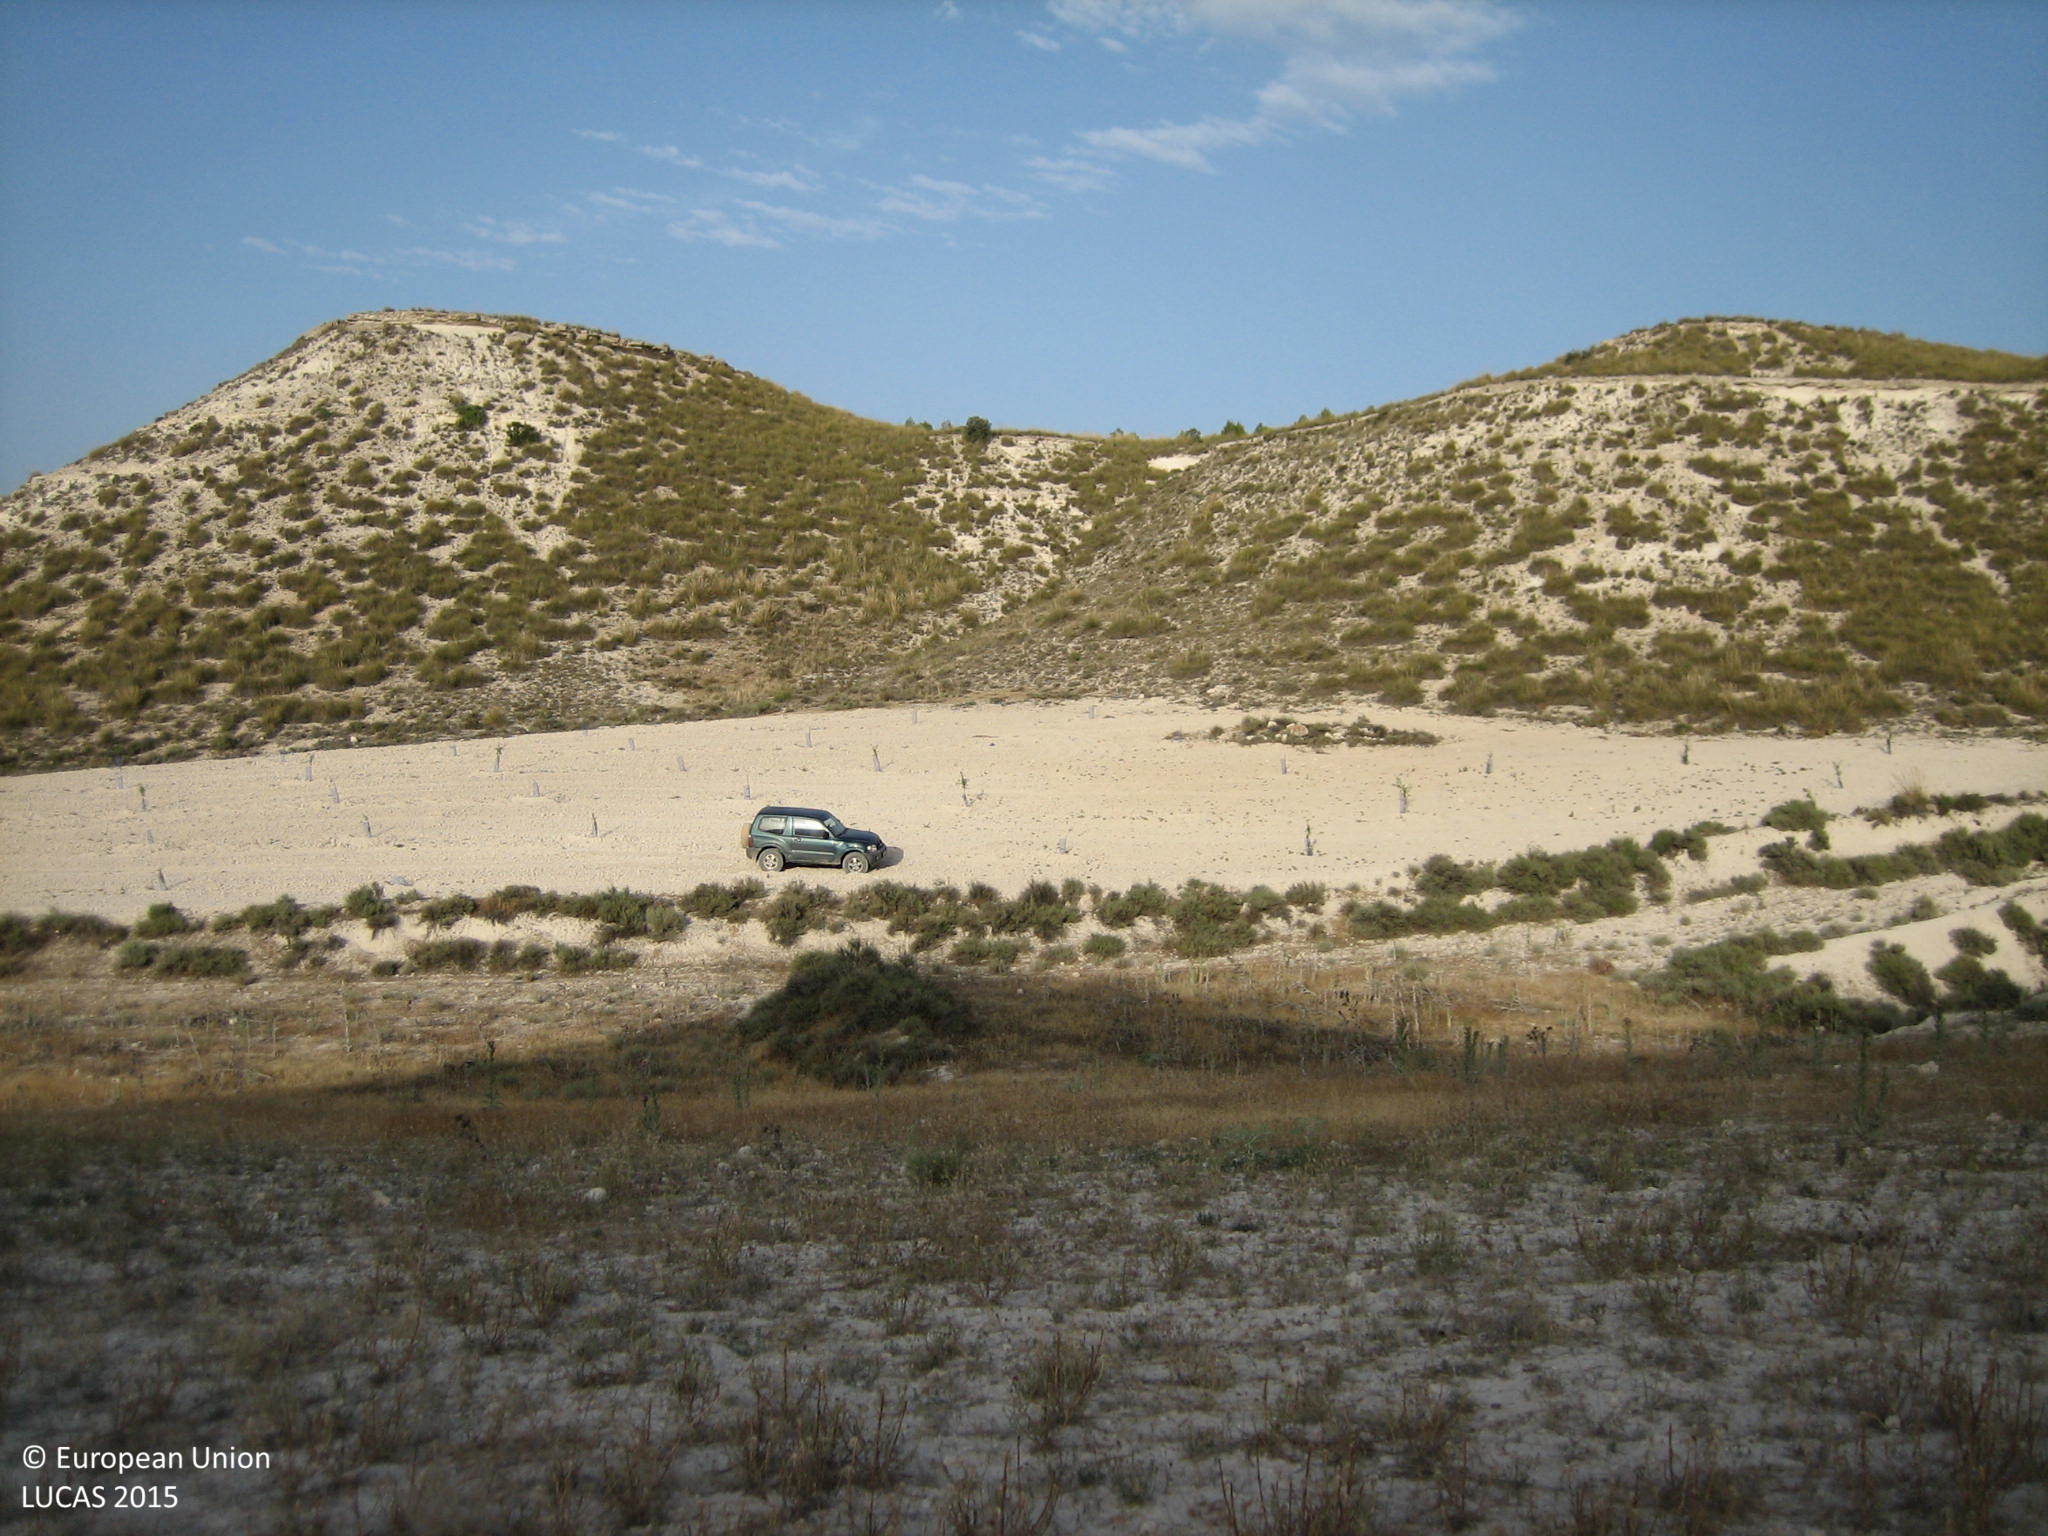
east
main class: Grassland
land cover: Spontaneously vegetated surfaces
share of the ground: 25 - 50 %
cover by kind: unconsolidated bare surface 70 %, herbaceous plants 30 %
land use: Fallow land
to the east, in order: Spontaneously vegetated surfaces; Grassland without tree/shrub cover; Nuts trees; Grassland without tree/shrub cover; Grassland with sparse tree/shrub cover
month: July
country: ES
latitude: 37.7370
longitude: -2.4135
